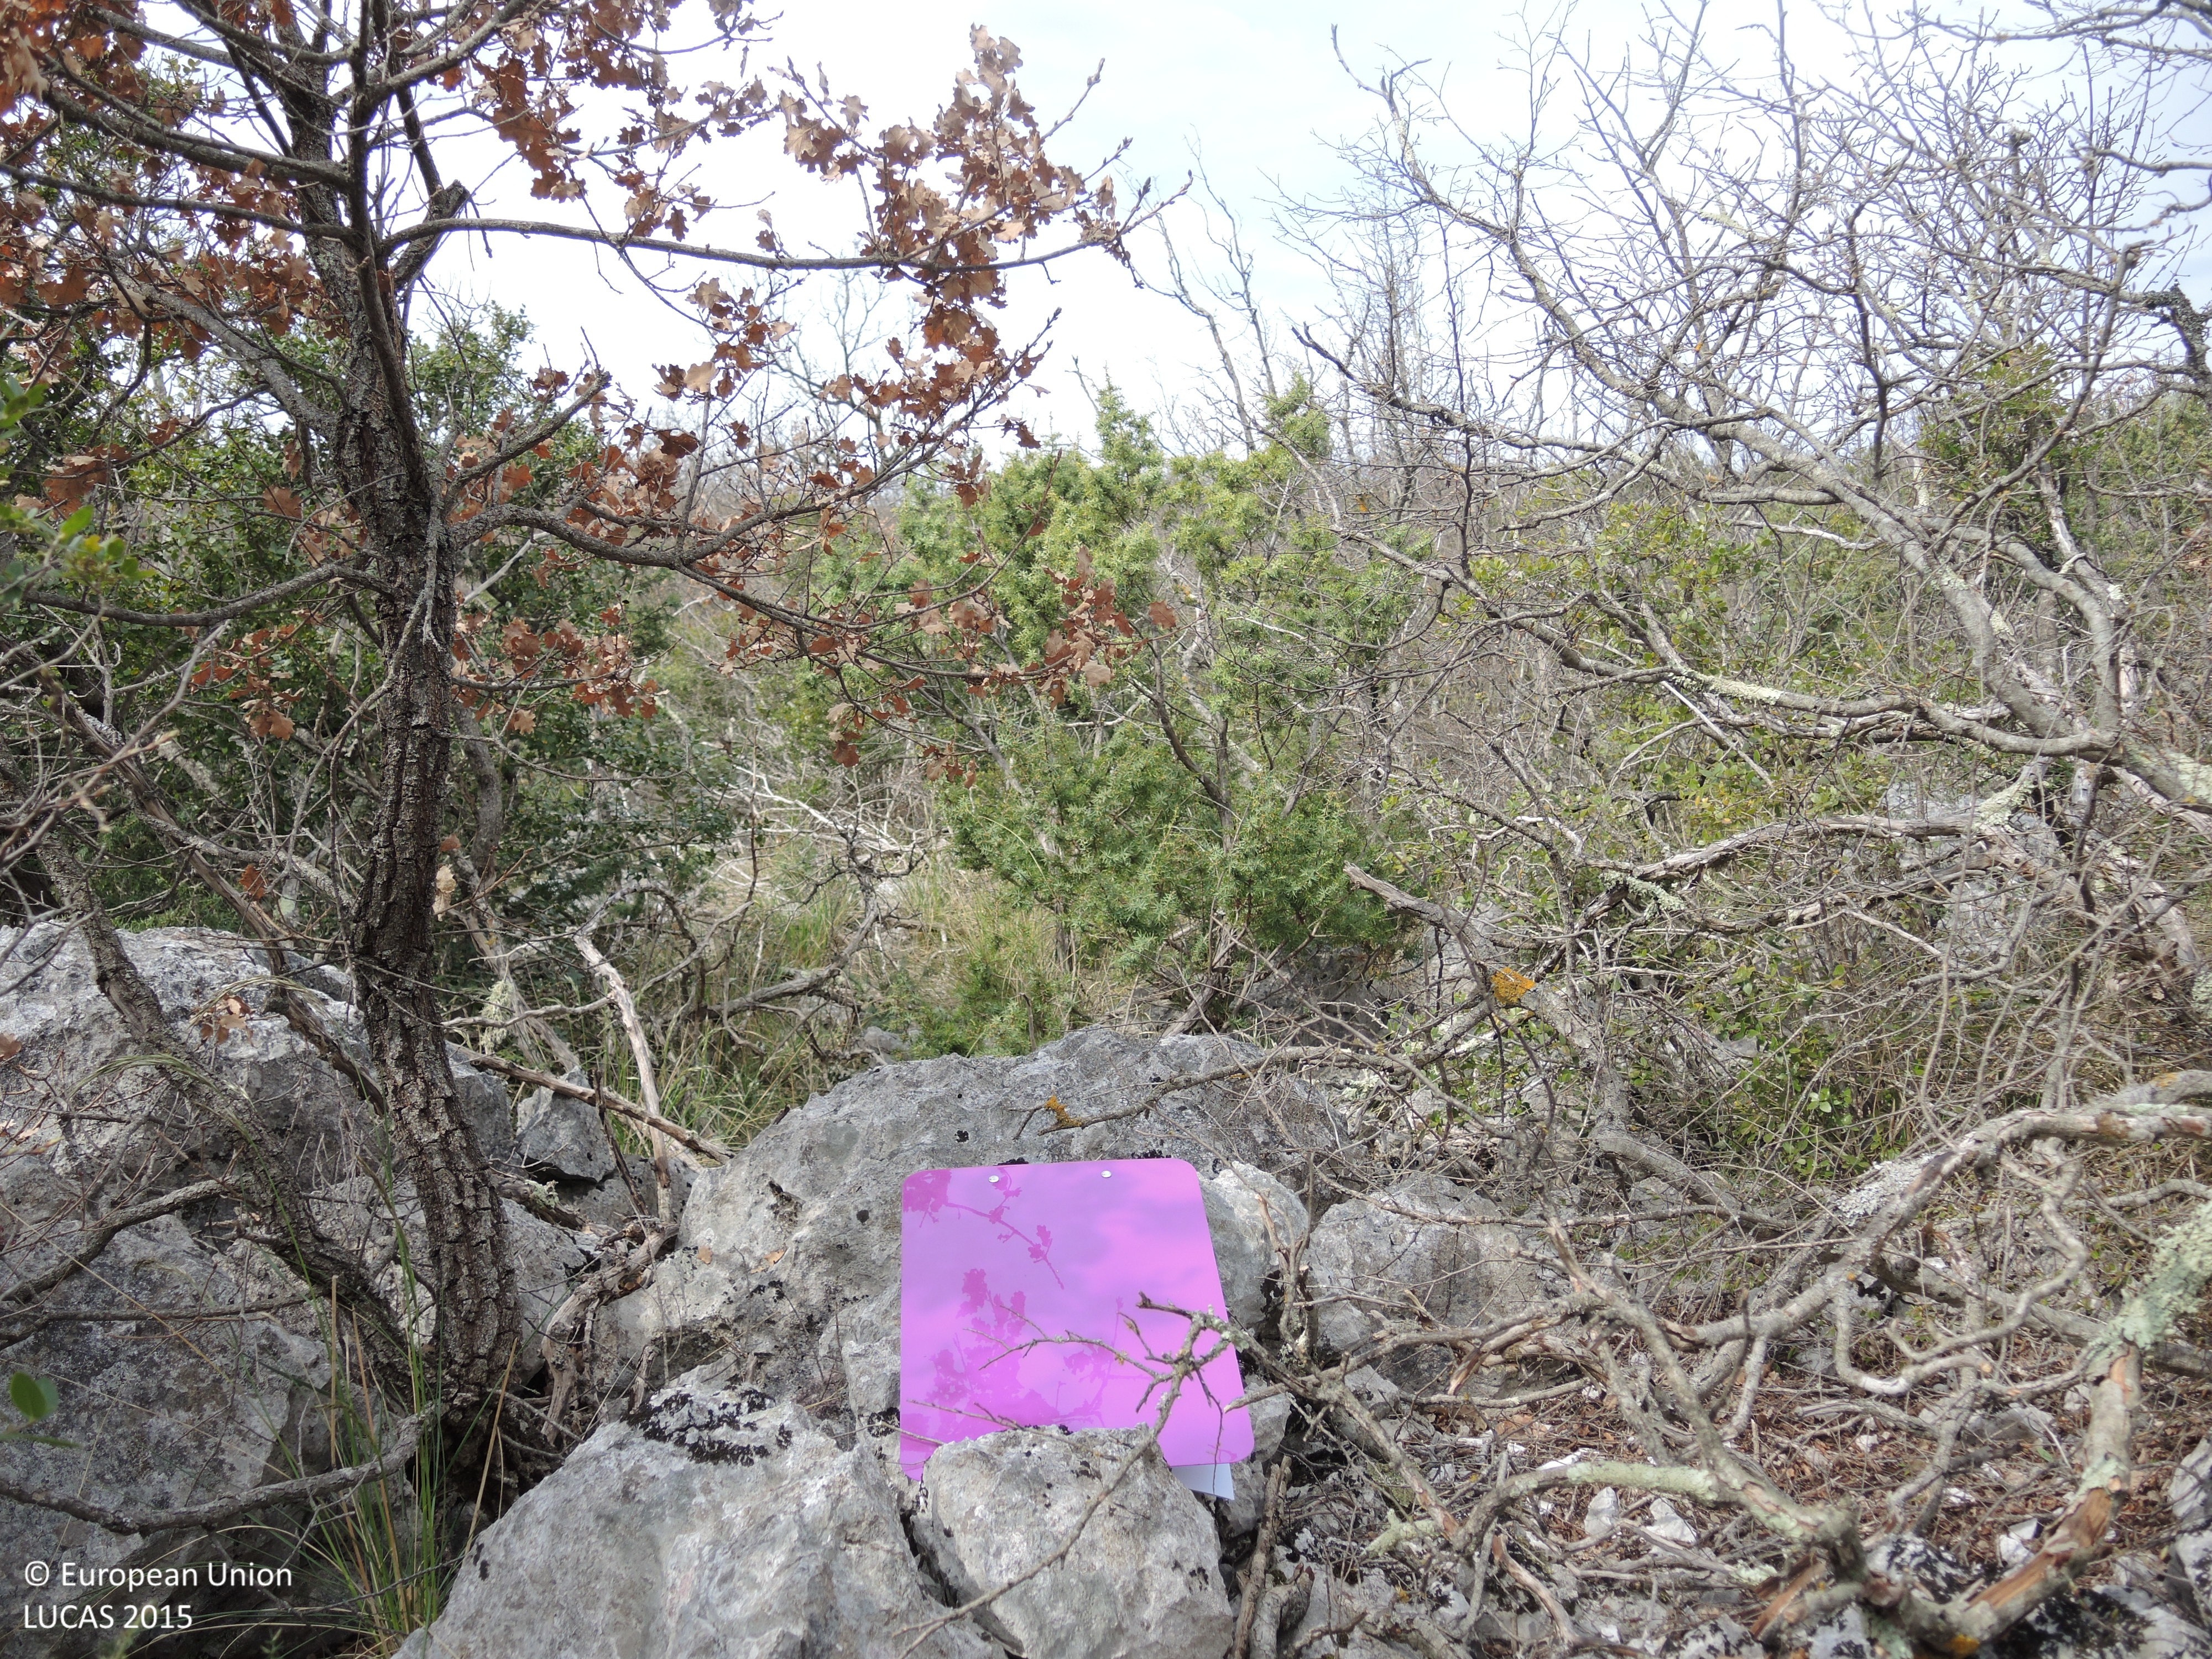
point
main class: Woodland
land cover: Other mixed woodland
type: mesophytic deciduous forest
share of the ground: > 75 %
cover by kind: broadleaved forest trees 30 %, shrubs 25 %, coniferous forest trees 20 %, consolidated bare surface 10 %, unconsolidated bare surface 10 %, herbaceous plants 5 %
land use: Semi-natural and natural areas not in use
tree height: < 5 m
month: April
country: HR
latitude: 43.8876
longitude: 15.6799
